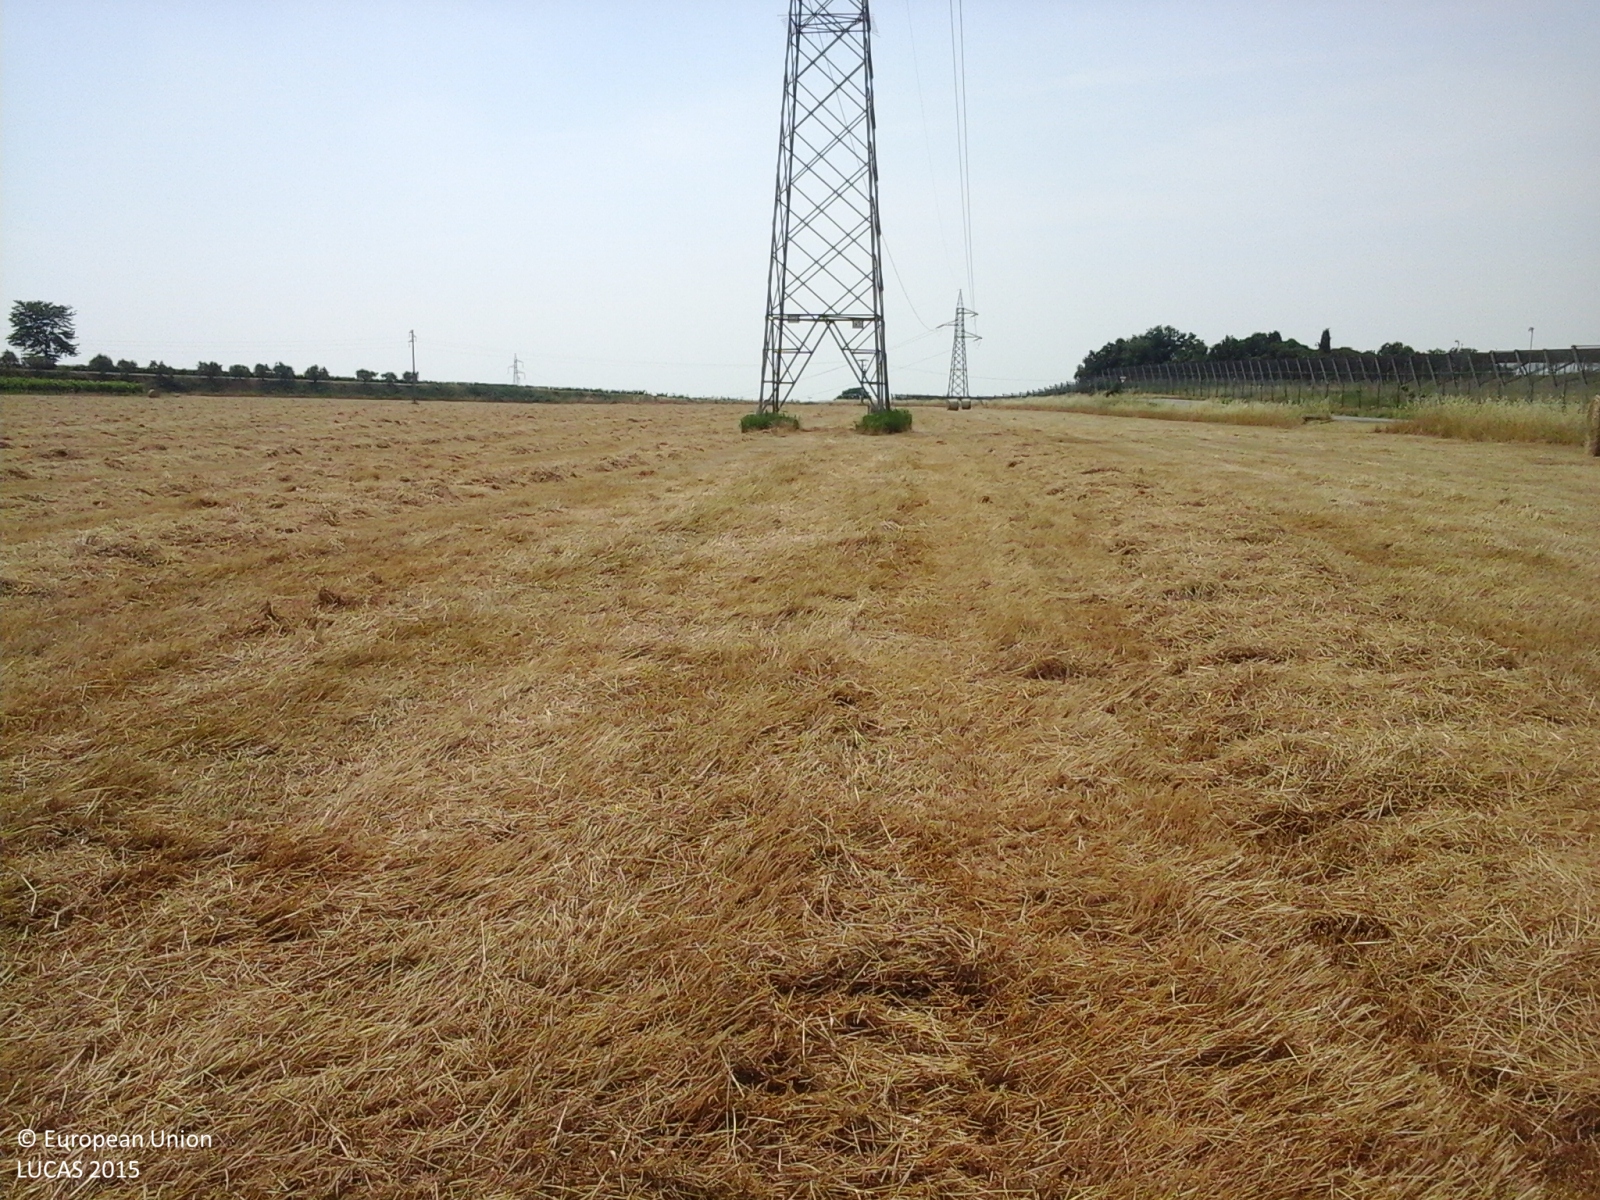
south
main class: Grassland
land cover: Grassland without tree/shrub cover
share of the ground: > 75 %
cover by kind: herbaceous plants 100 %
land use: Agriculture (excluding fallow land and kitchen gardens)
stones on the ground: < 10 %
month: June
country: IT
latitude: 45.3756
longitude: 10.7521
